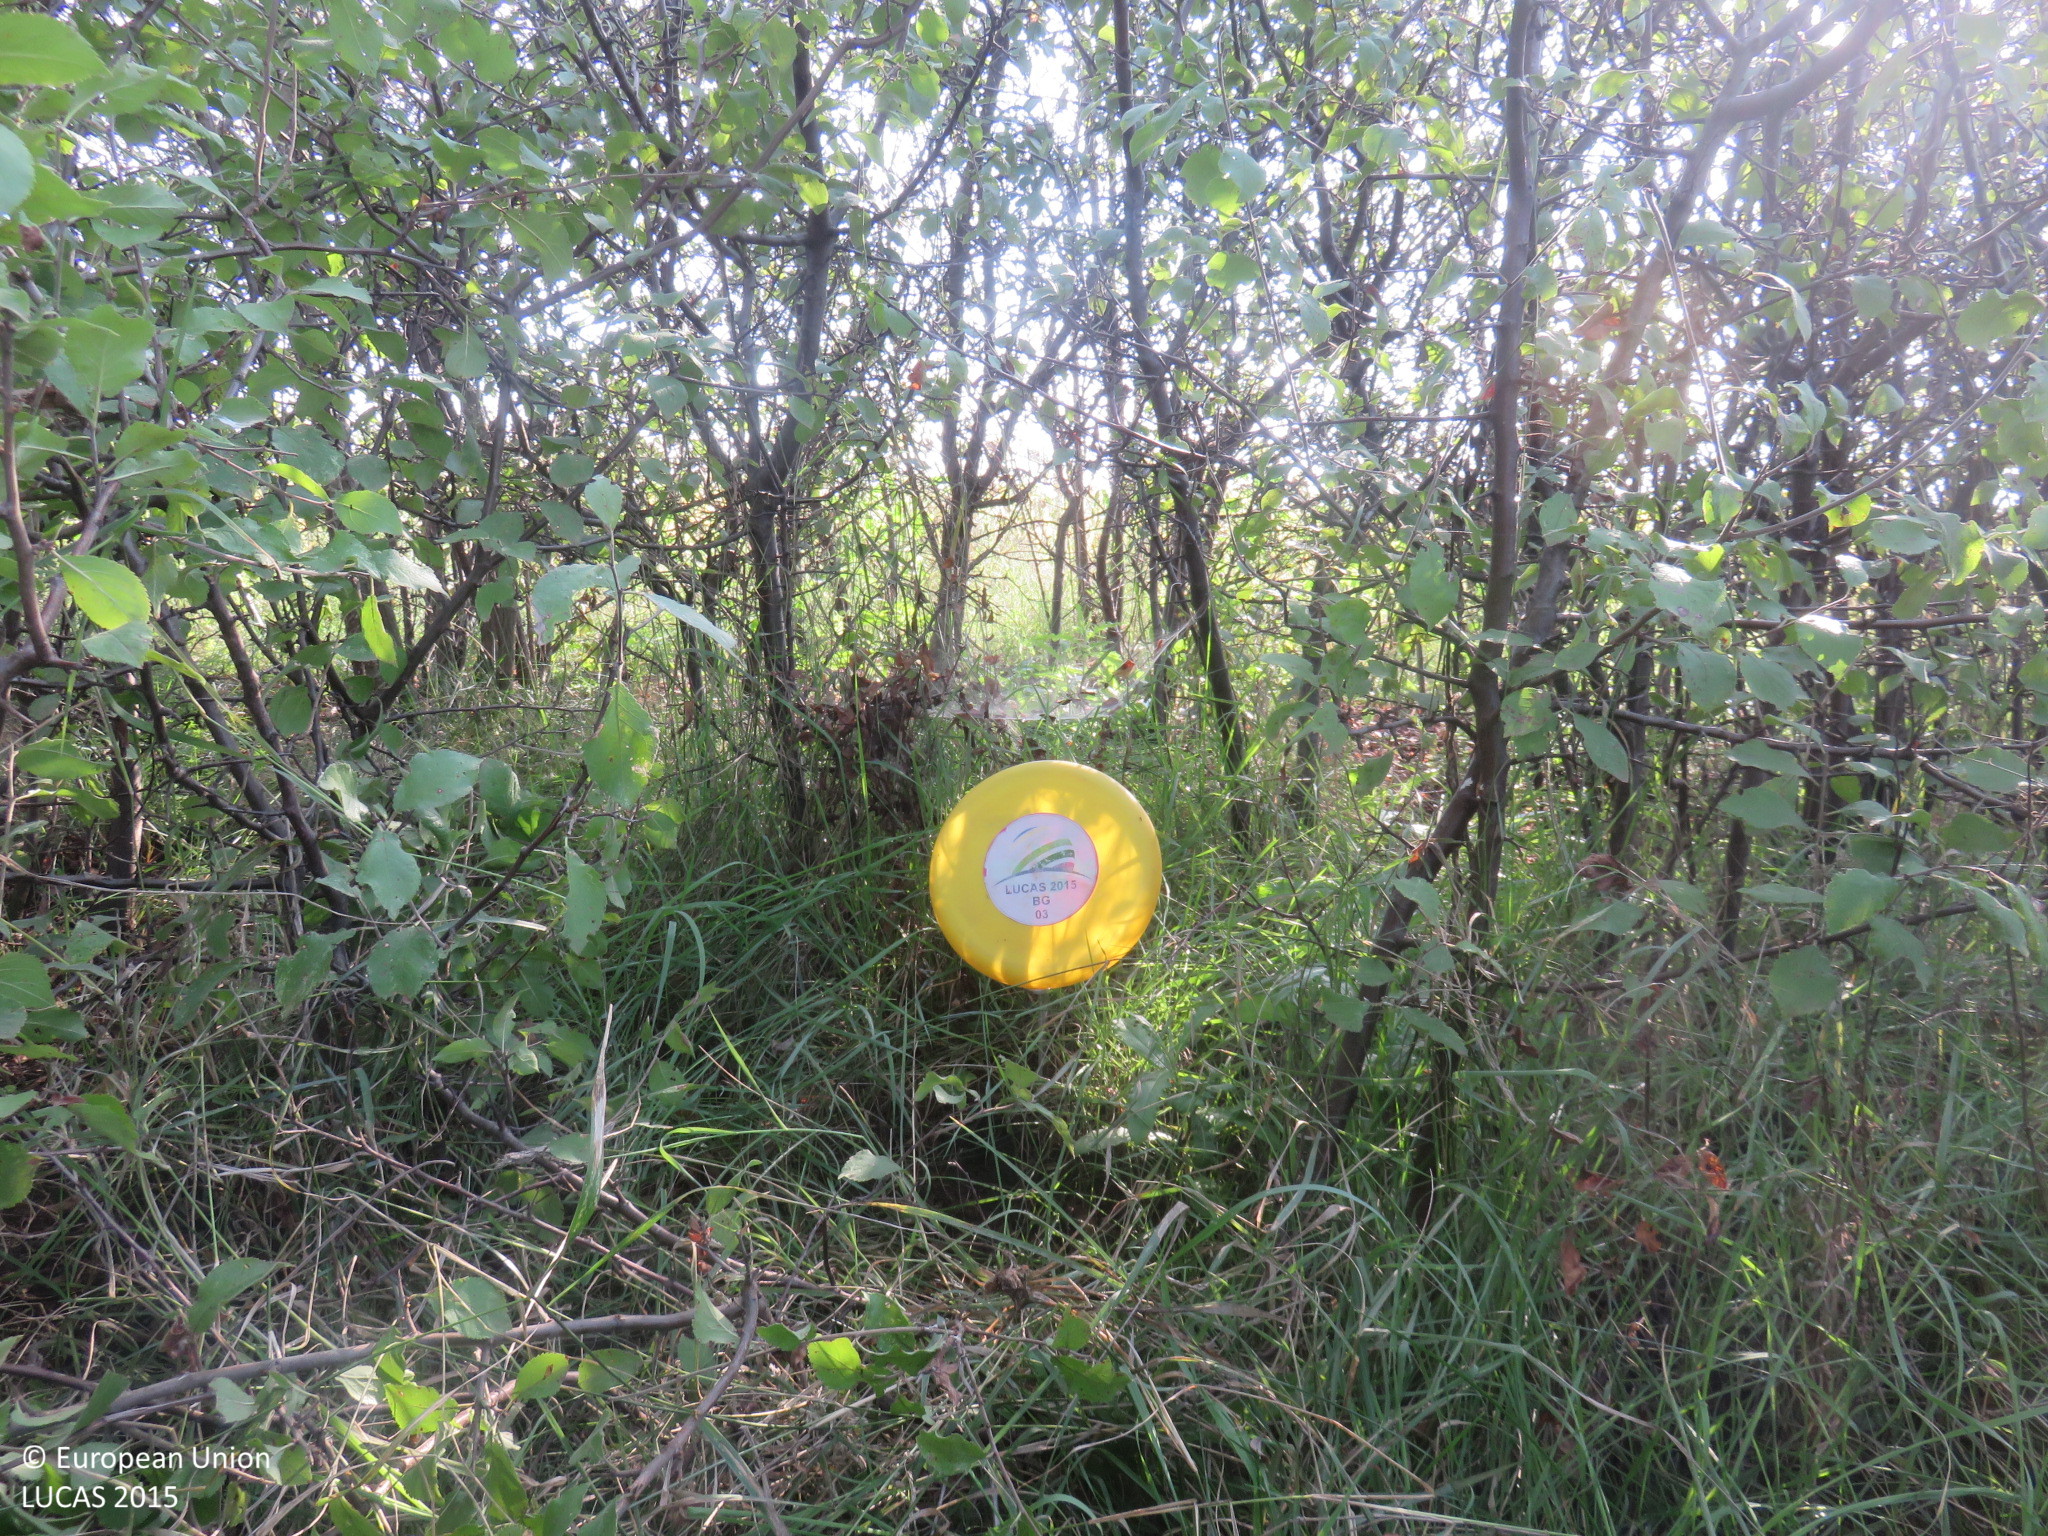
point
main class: Shrubland
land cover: Shrubland with sparse tree cover
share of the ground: > 75 %
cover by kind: shrubs 95 %, broadleaved forest trees 5 %
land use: Semi-natural and natural areas not in use
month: September
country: BG
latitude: 43.1633
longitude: 24.9865
